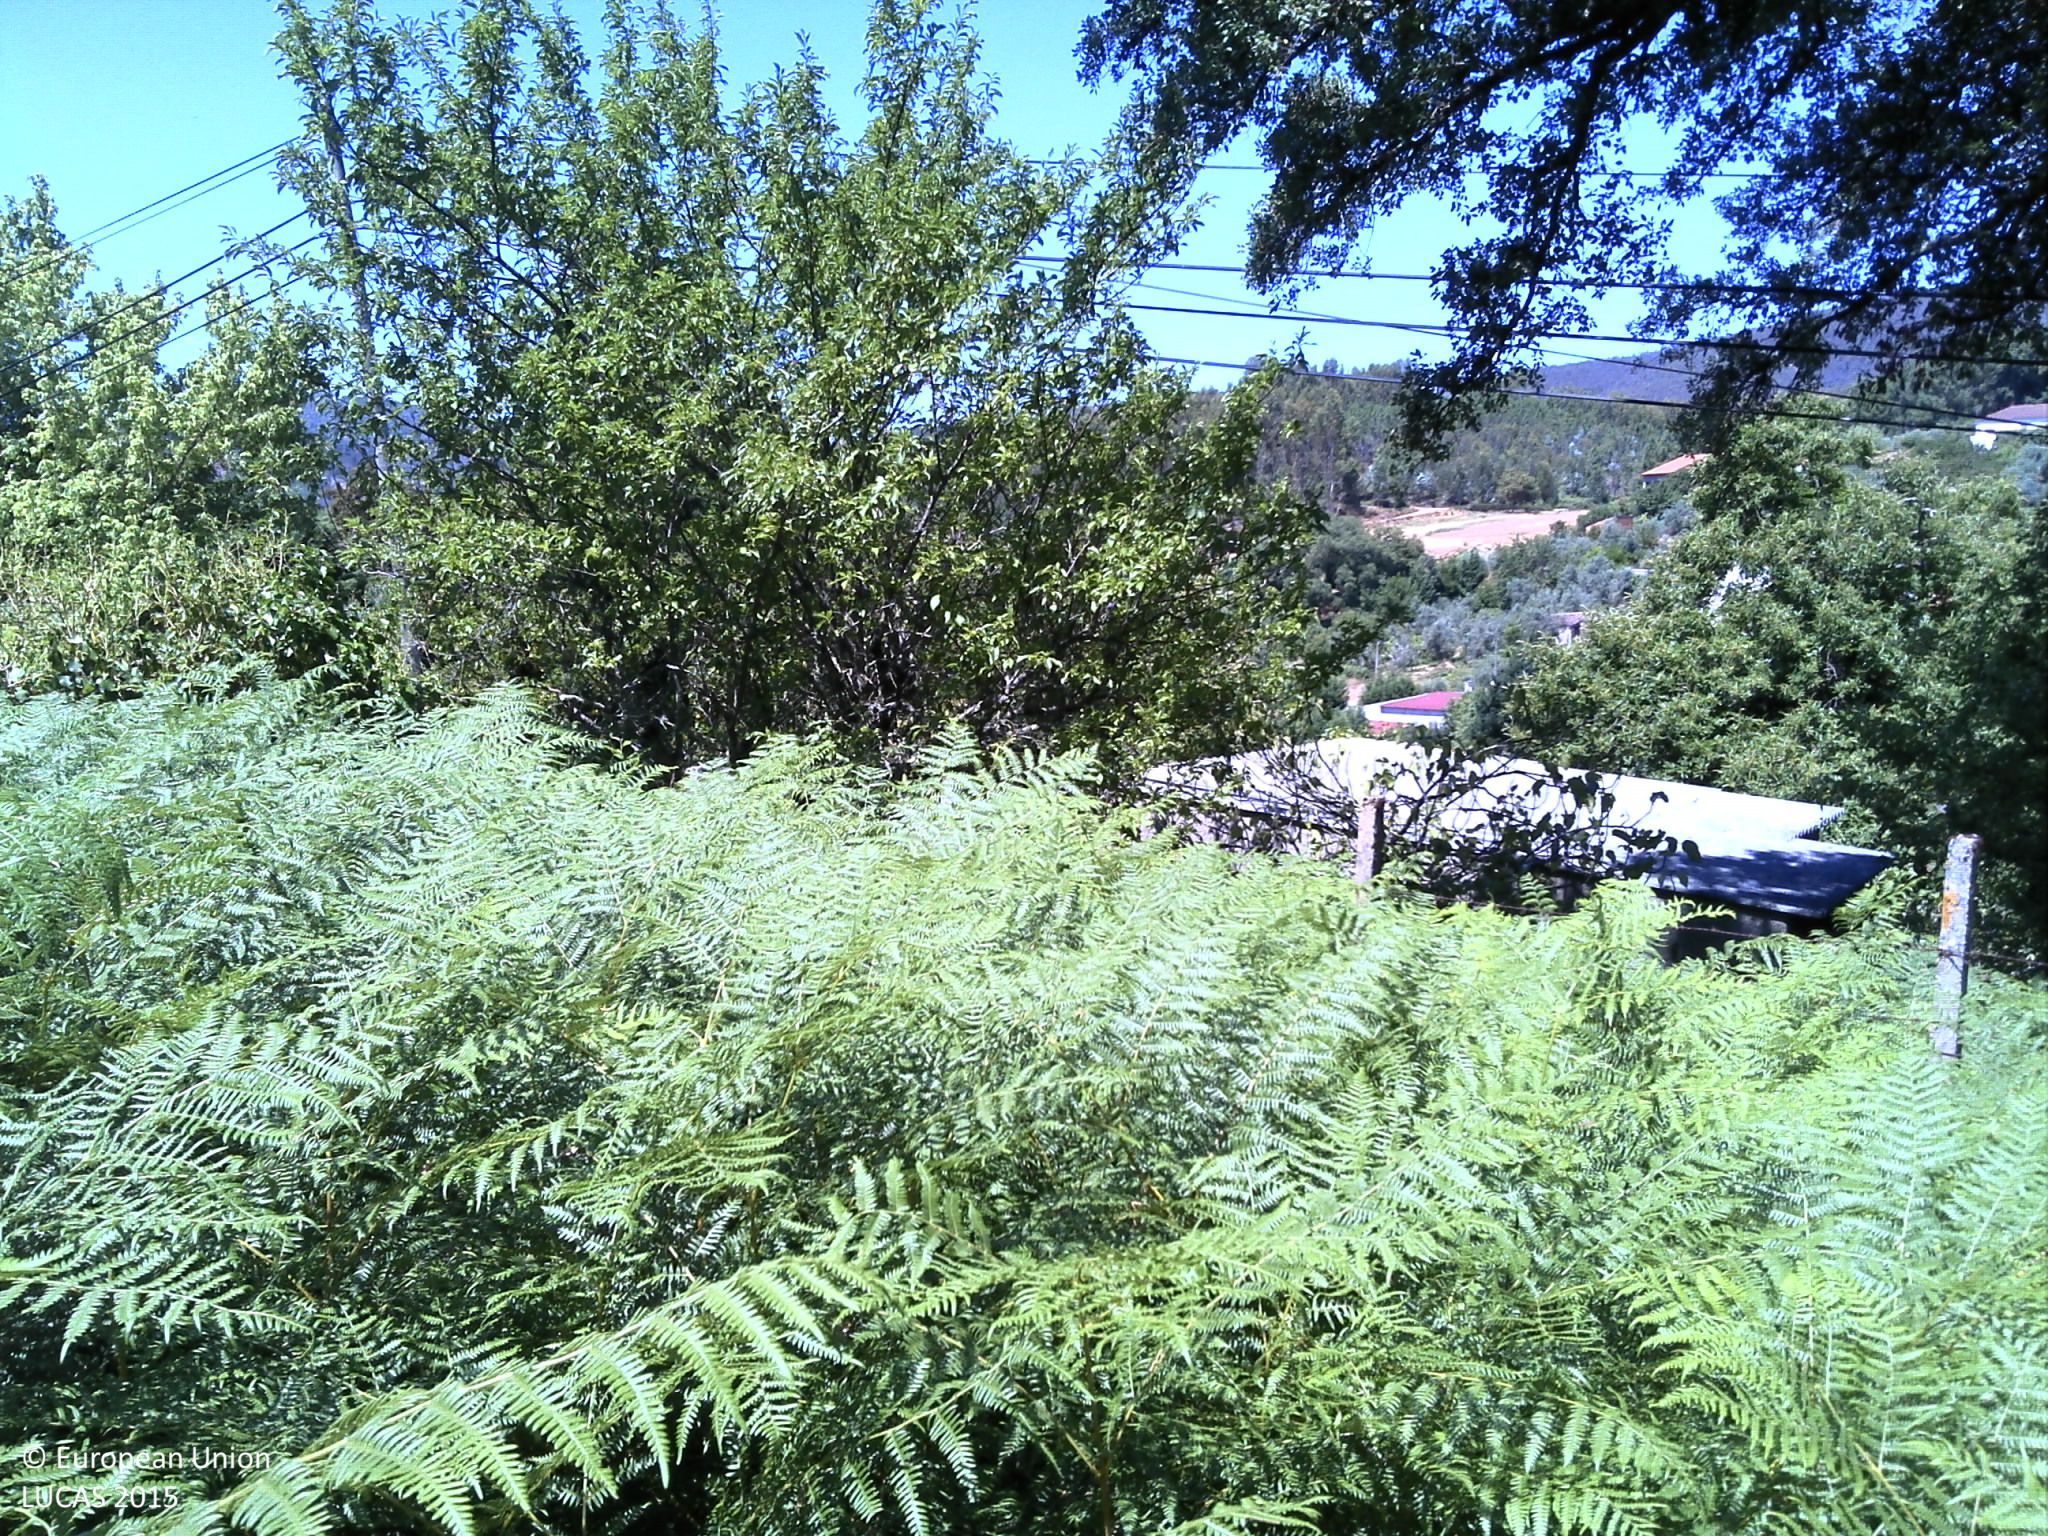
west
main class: Shrubland
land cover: Shrubland with sparse tree cover
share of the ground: > 75 %
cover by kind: shrubs 90 %, broadleaved forest trees 5 %, unconsolidated bare surface 5 %
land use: Abandoned areas
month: July
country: PT
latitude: 39.9881
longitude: -8.2144
